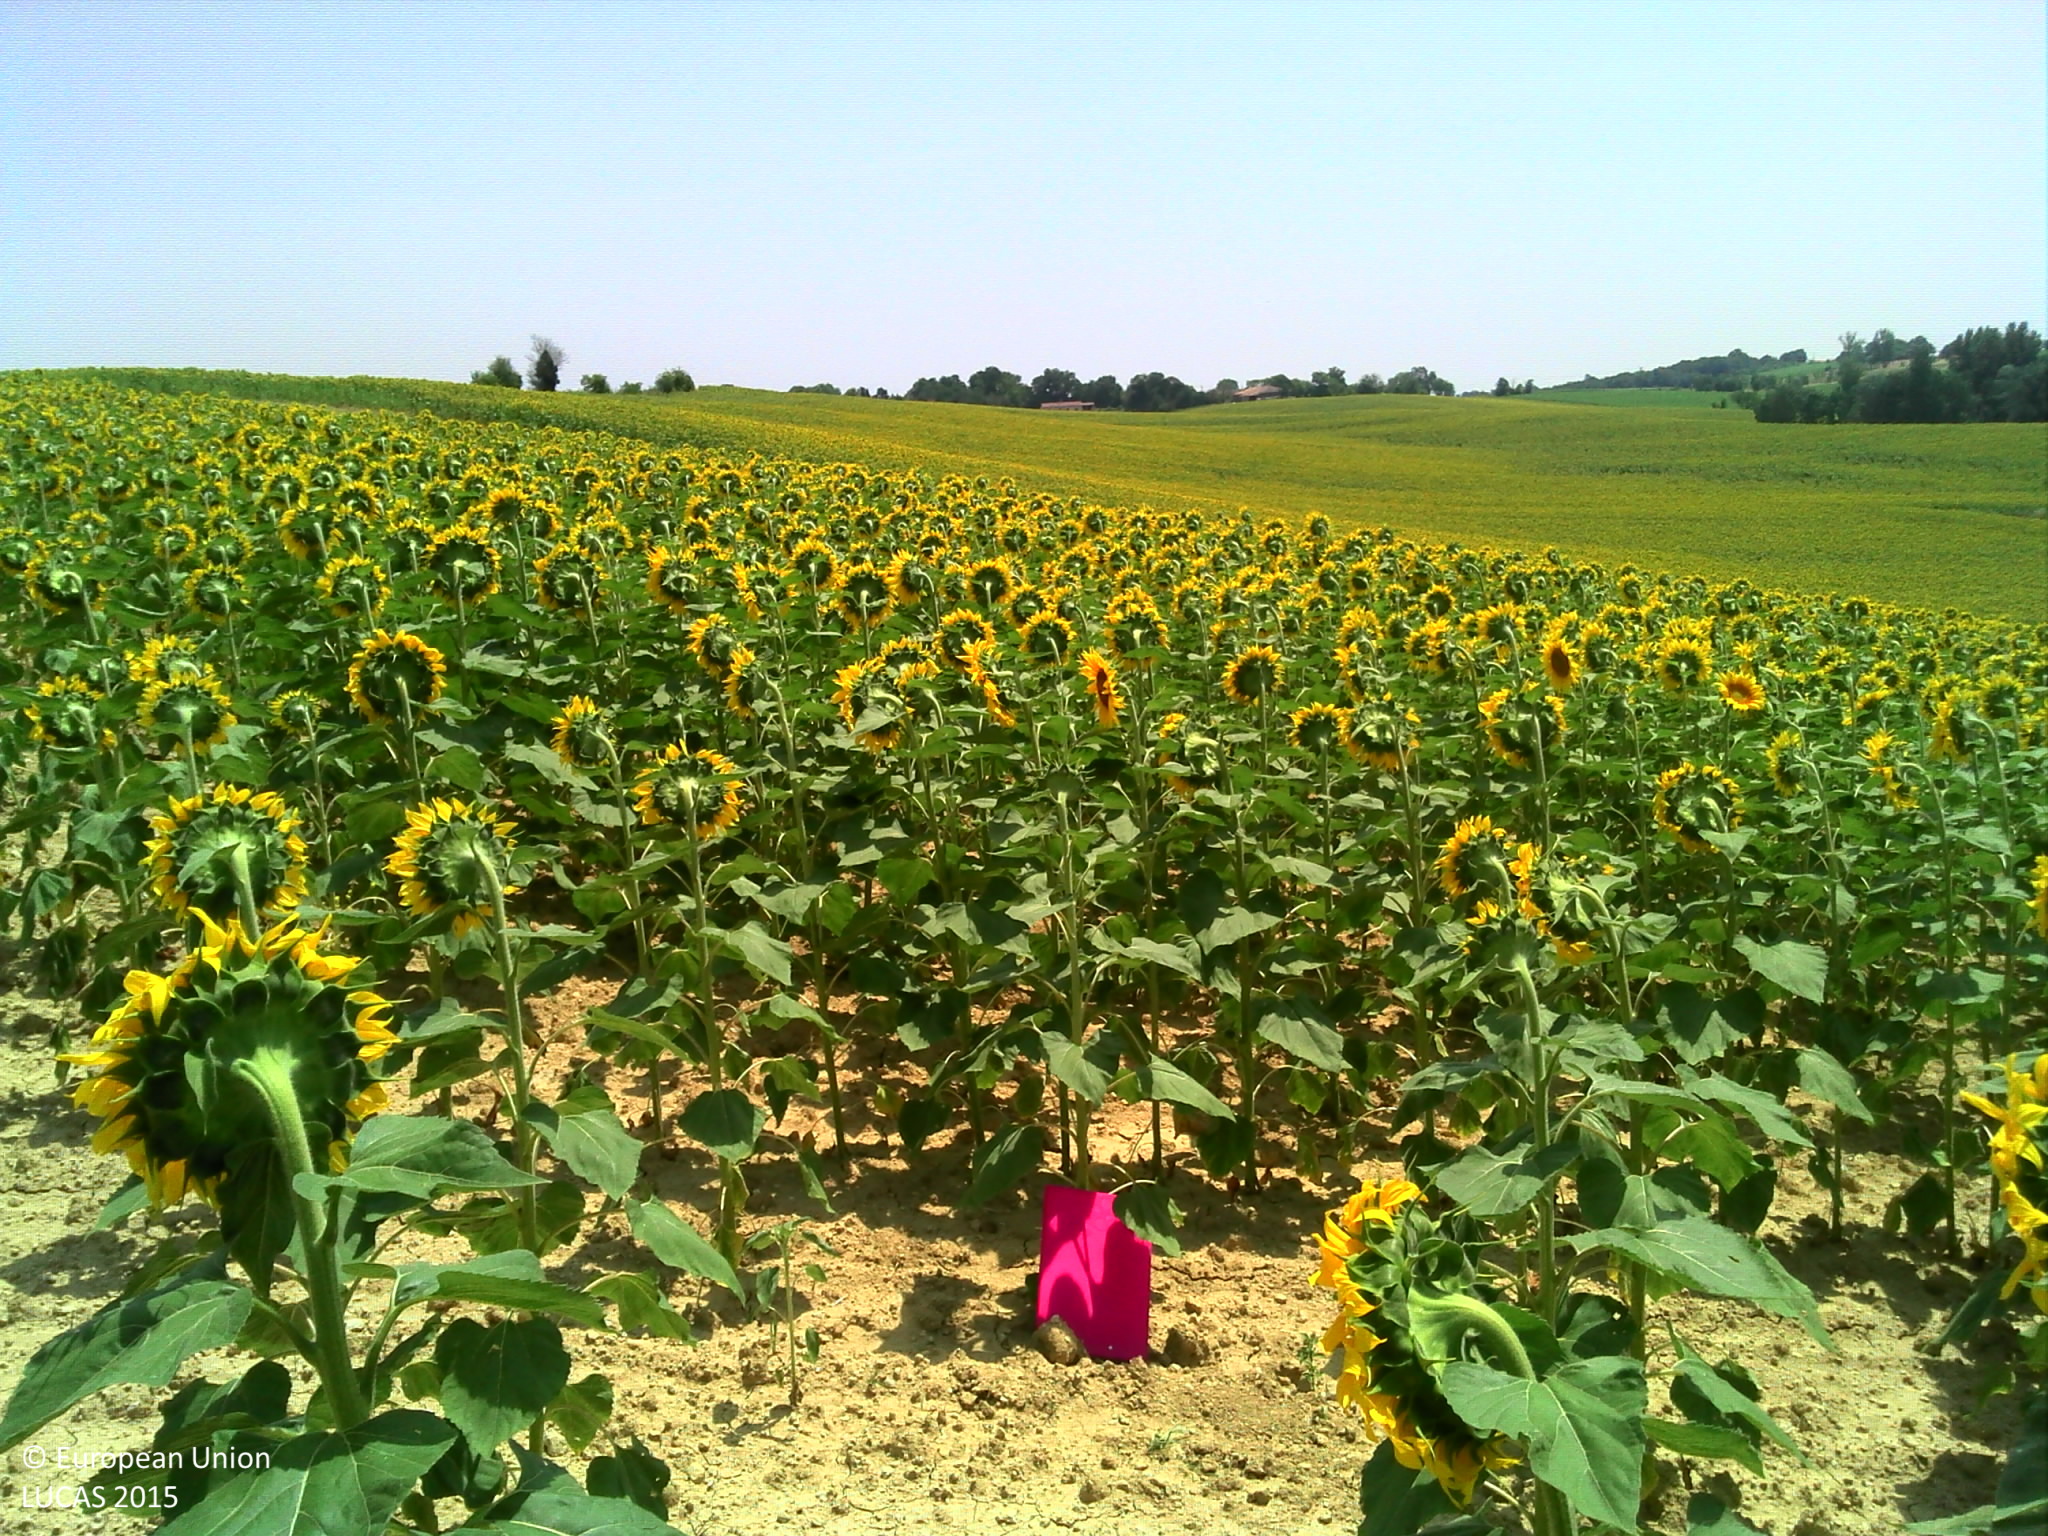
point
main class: Cropland
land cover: Sunflower
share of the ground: > 75 %
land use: Agriculture (excluding fallow land and kitchen gardens)
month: July
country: FR
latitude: 43.6893
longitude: 1.0303
